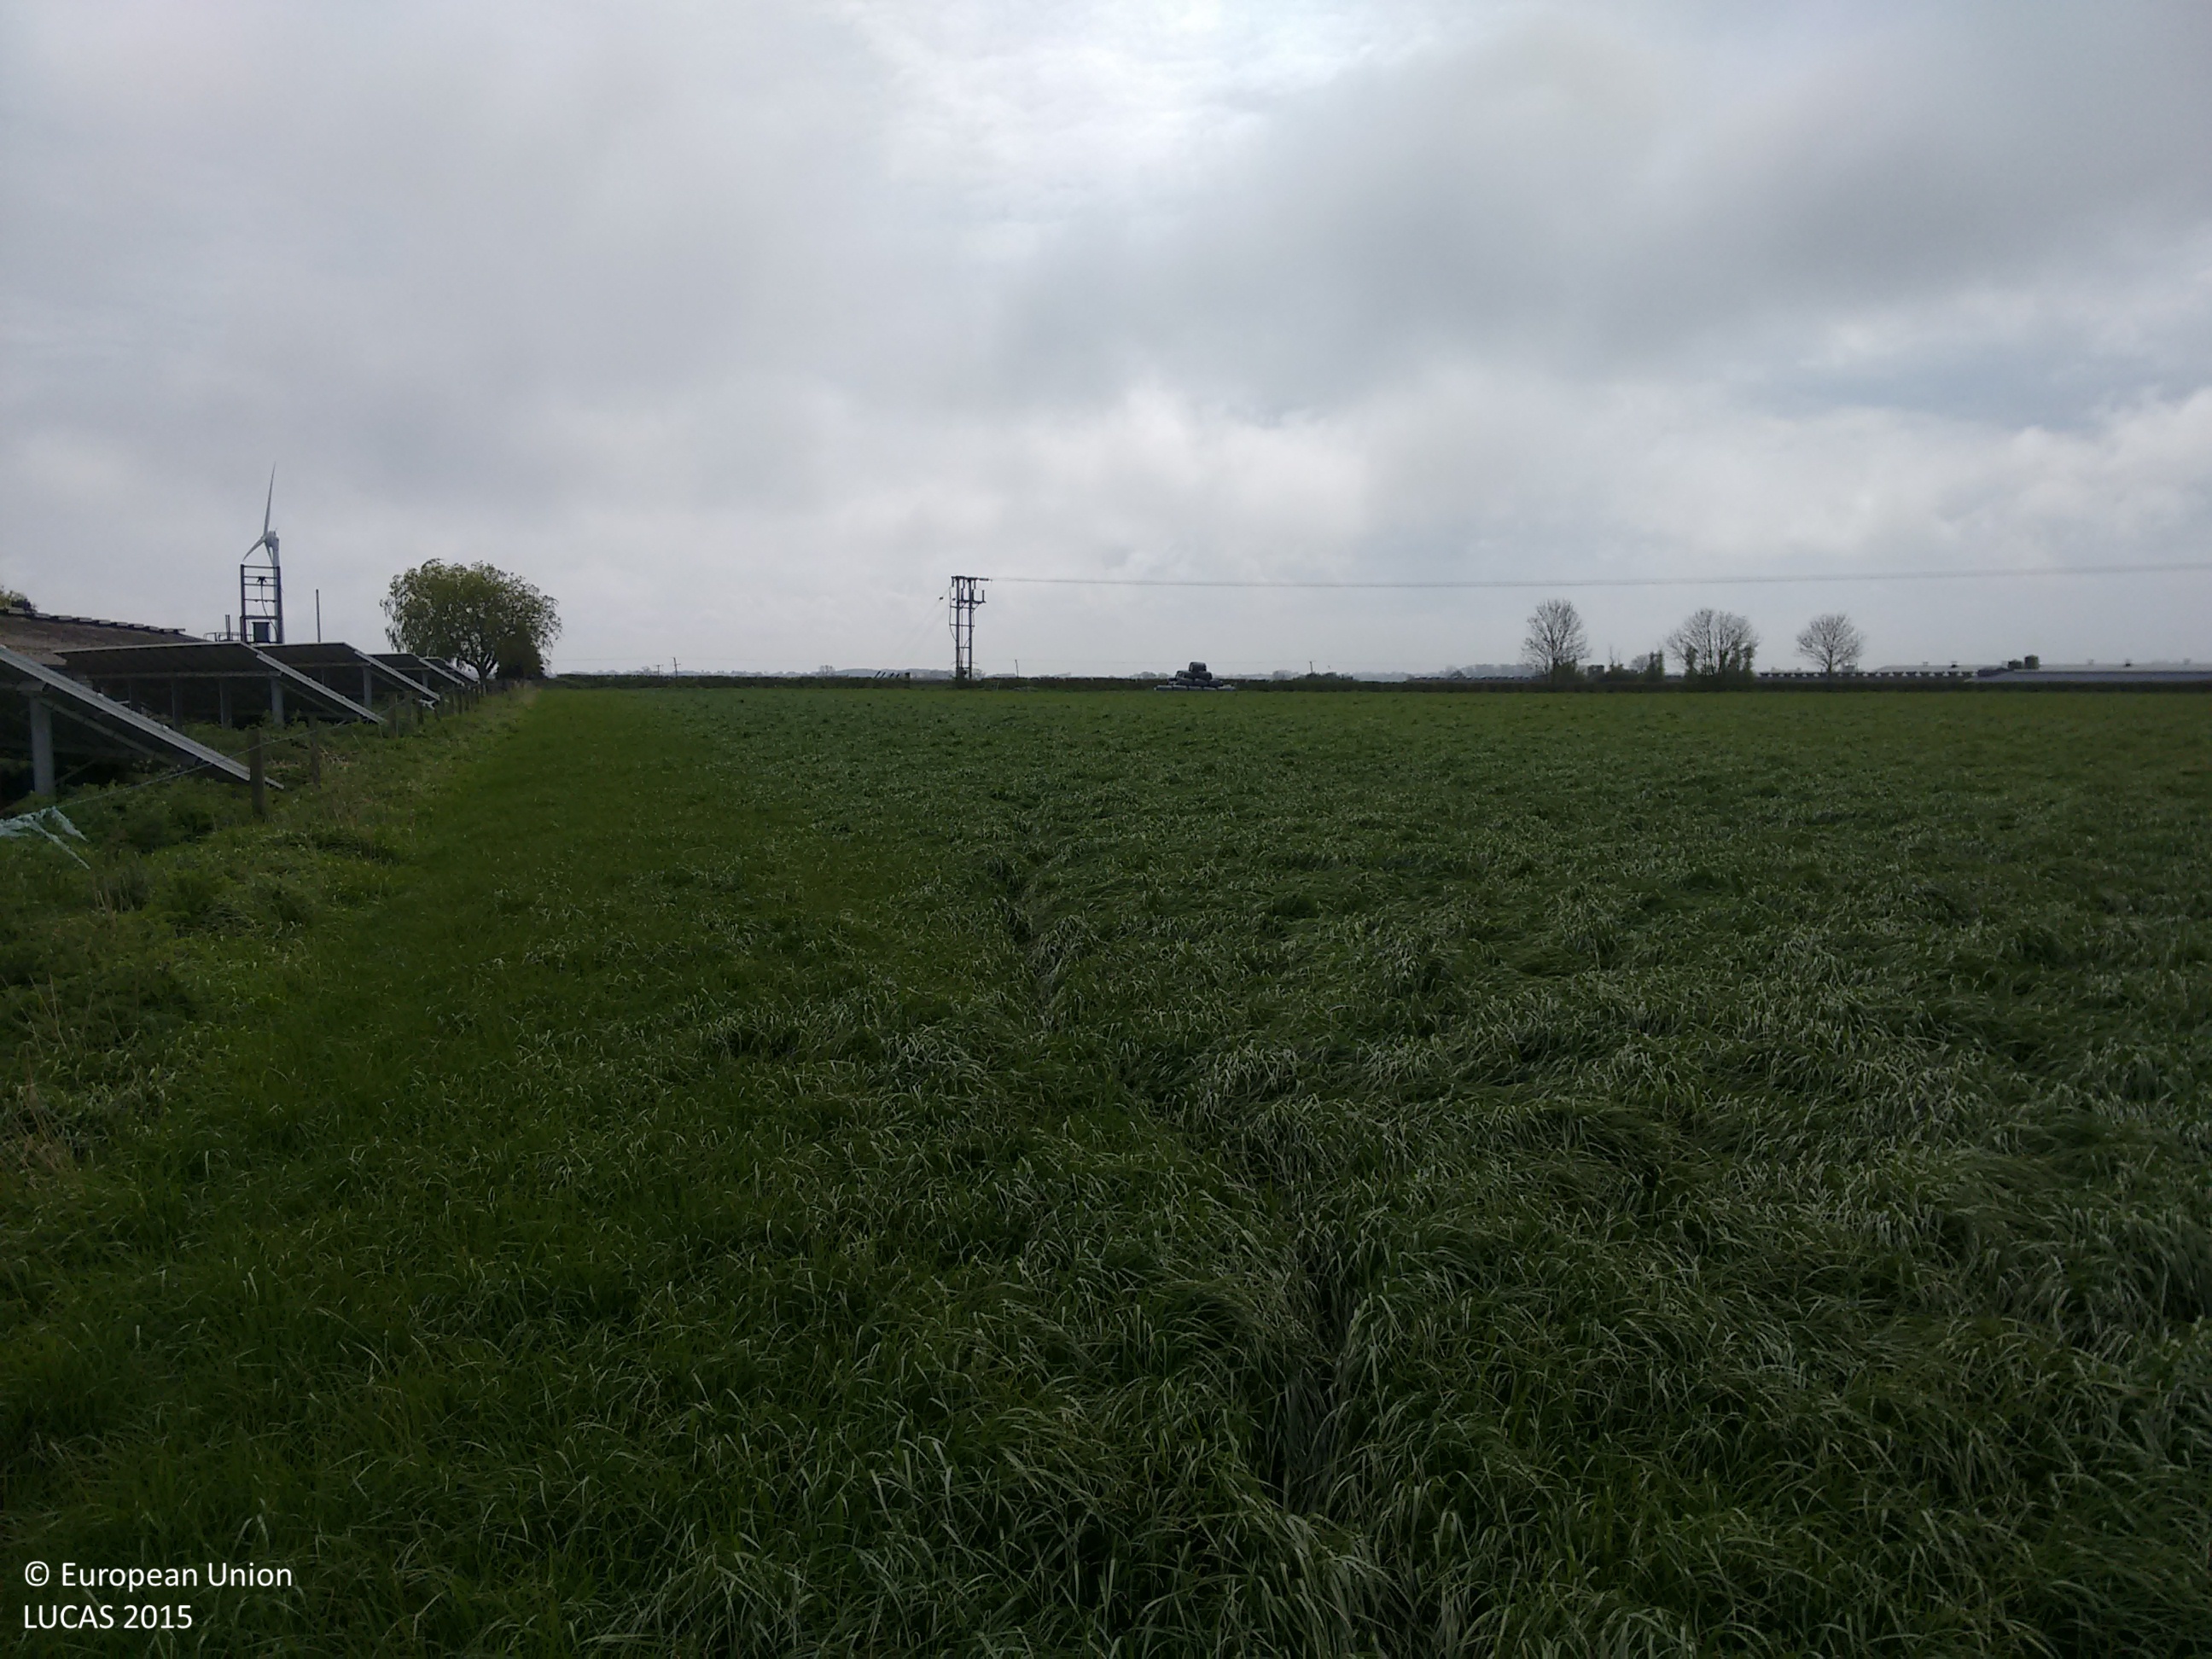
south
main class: Grassland
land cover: Grassland without tree/shrub cover
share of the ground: > 75 %
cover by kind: herbaceous plants 100 %
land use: Agriculture (excluding fallow land and kitchen gardens)
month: May
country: GB
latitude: 53.9569
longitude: -0.3215
